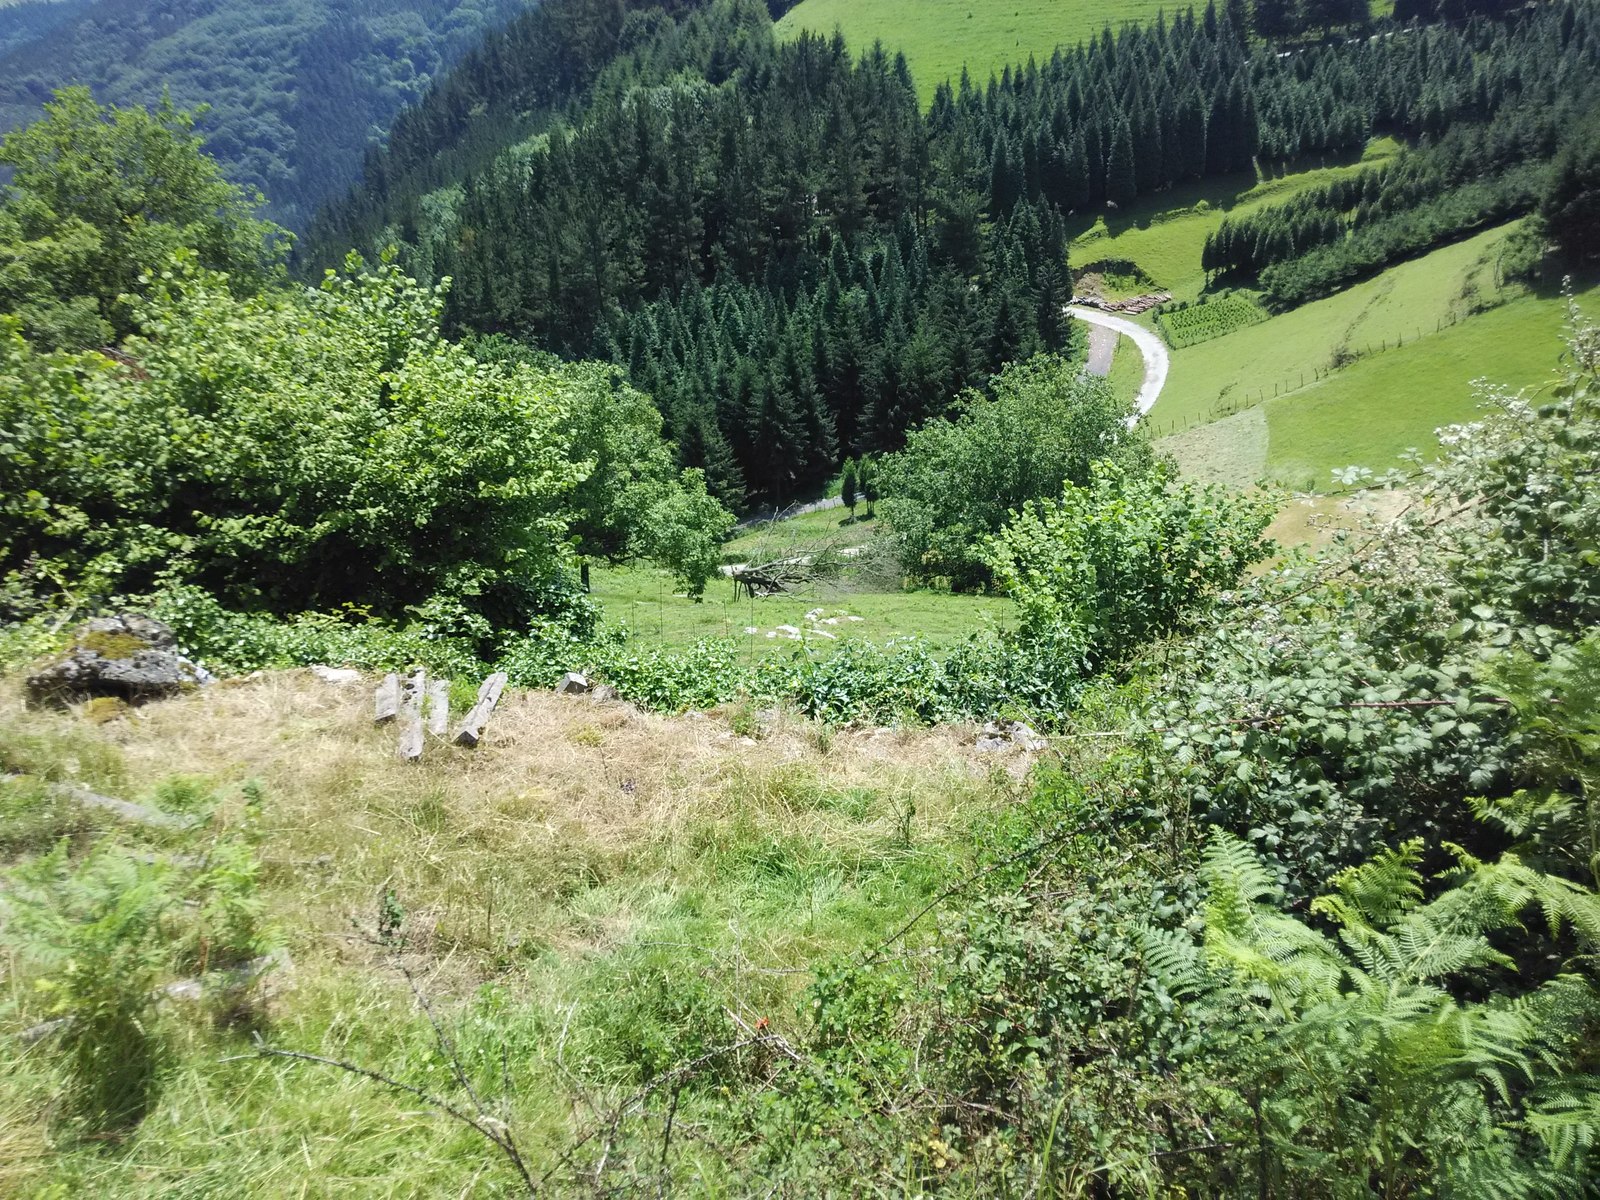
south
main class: Grassland
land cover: Grassland without tree/shrub cover
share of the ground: > 75 %
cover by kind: herbaceous plants 100 %
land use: Agriculture (excluding fallow land and kitchen gardens)
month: July
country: ES
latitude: 43.1852
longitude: -2.2421
